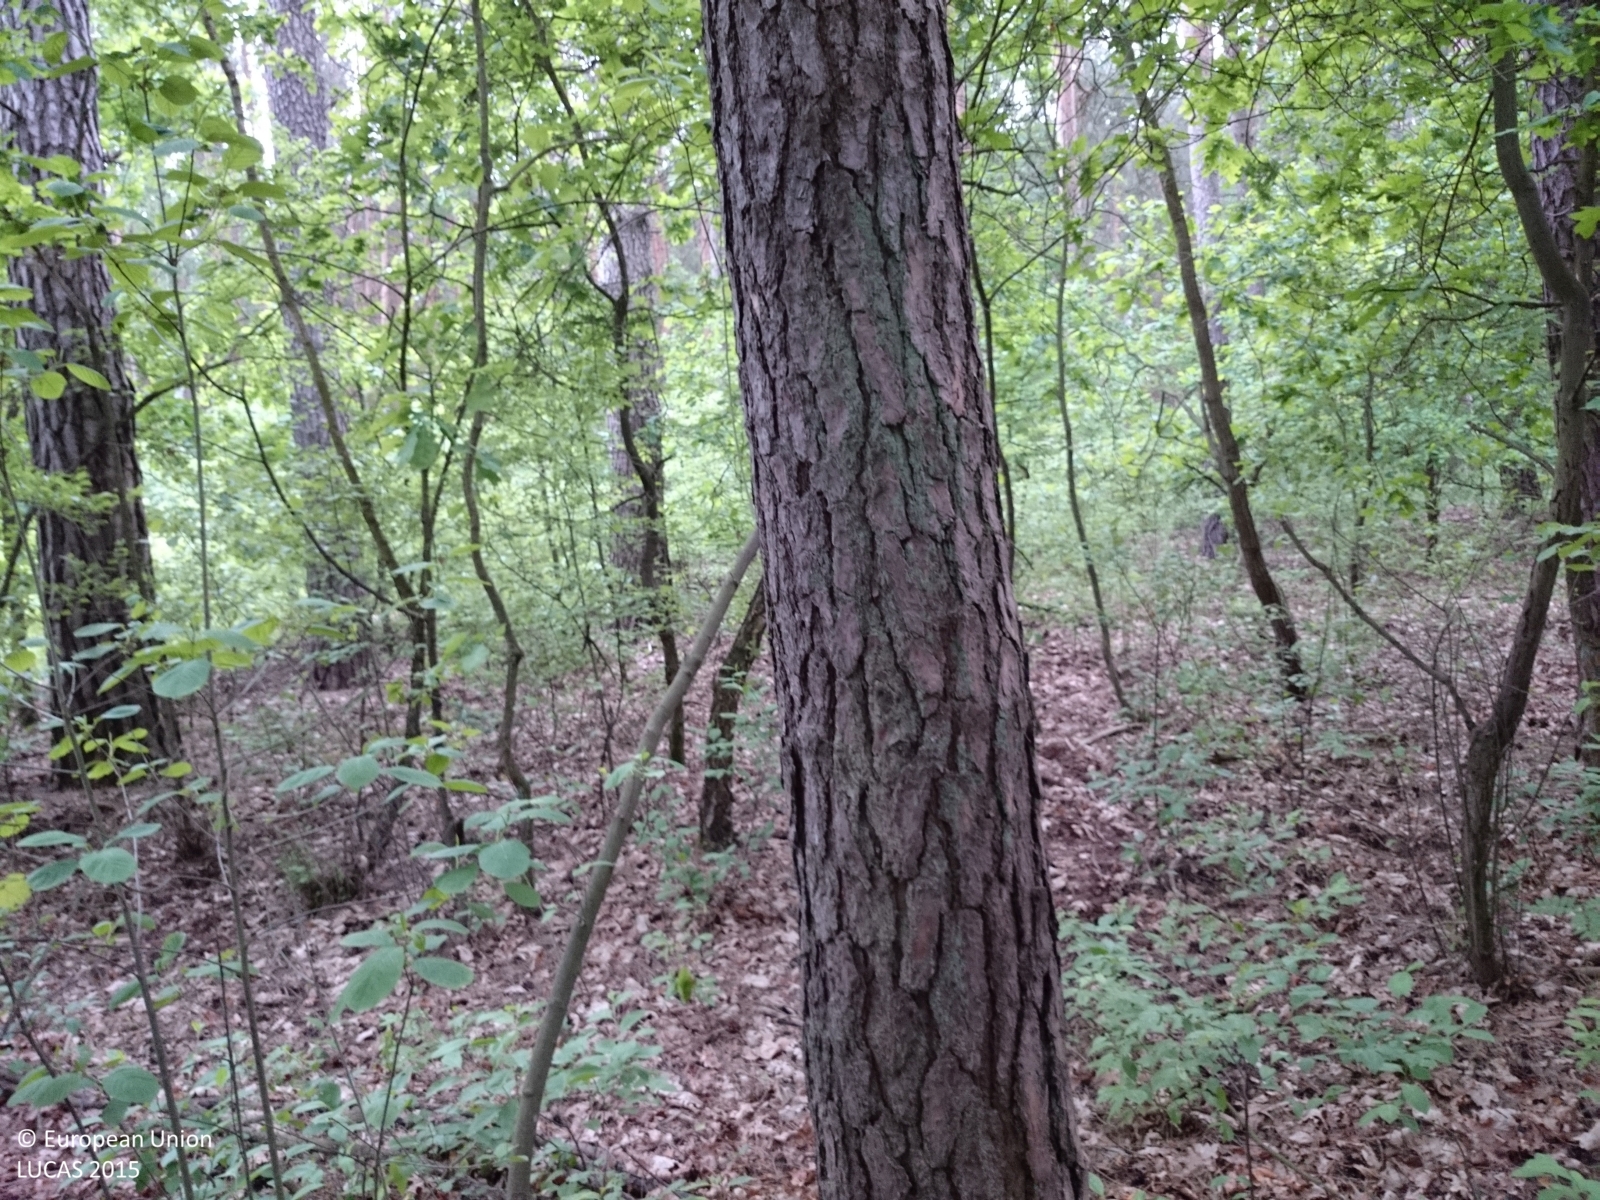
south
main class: Woodland
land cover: Pine dominated mixed woodland
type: hemiboreal forest and nemoral coniferous forest and mixed broadleaved-coniferous forest
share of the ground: > 75 %
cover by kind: coniferous forest trees 75 %, broadleaved forest trees 25 %
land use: Forestry
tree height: > 5 m
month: May
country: PL
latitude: 52.6029
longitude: 15.6595
